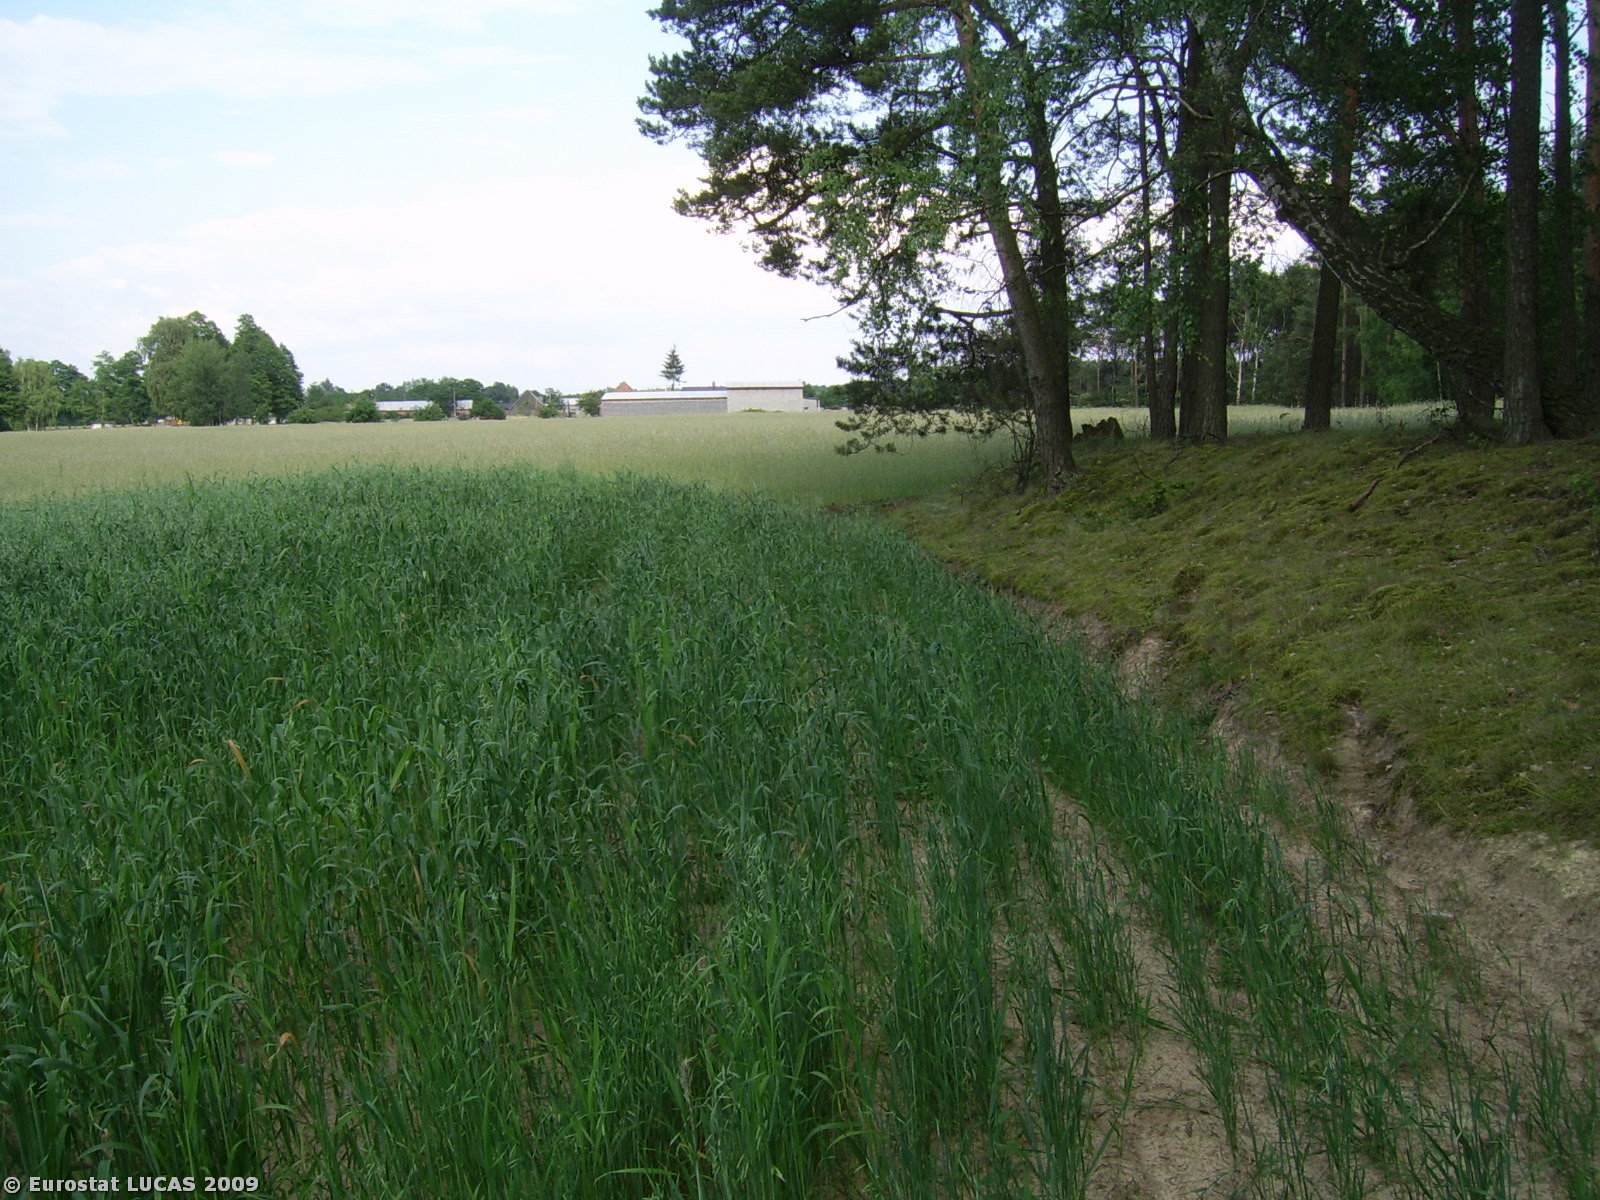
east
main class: Cropland
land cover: Oats
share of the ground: > 75 %
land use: Agriculture (excluding fallow land and kitchen gardens)
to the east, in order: Oats; Grass margins; Triticale; Grass margins; Tracks; Grassland without tree/shrub cover; Tracks; Triticale; Fences; Artificial constructions in urban areas
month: June
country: PL
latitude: 52.1029
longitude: 17.7959
